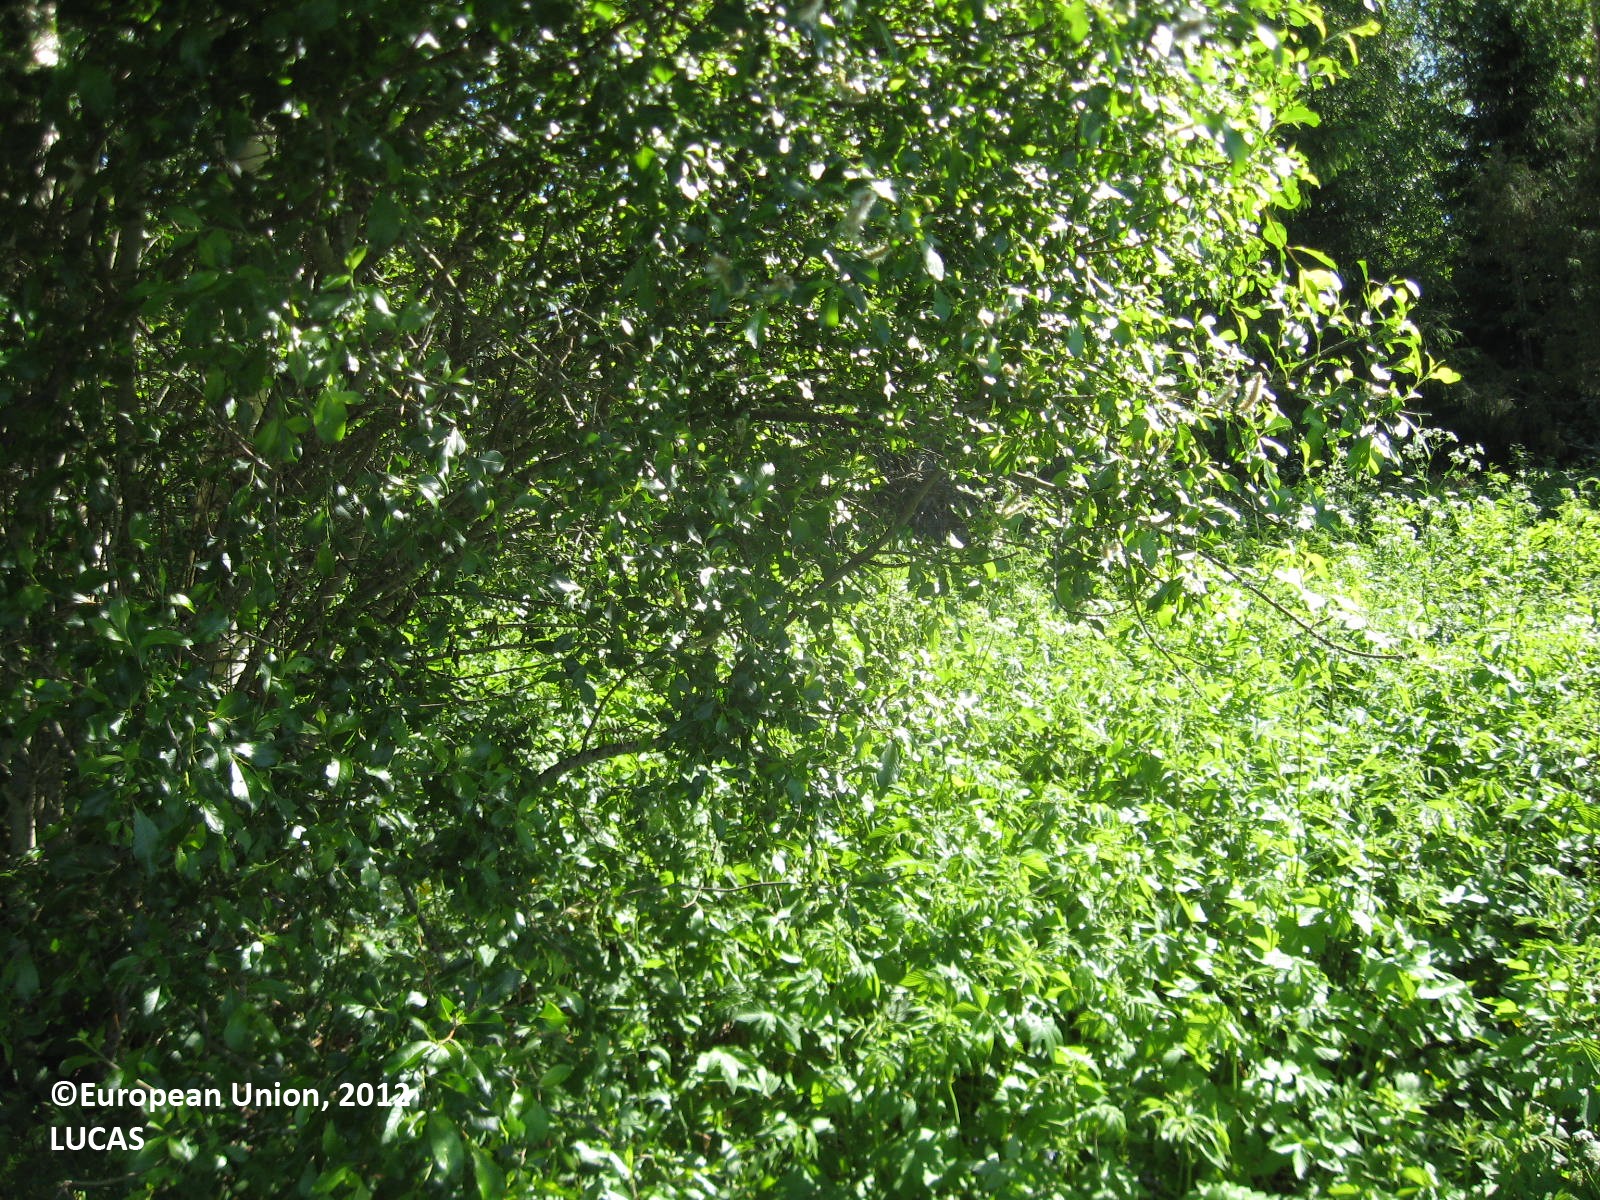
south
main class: Cropland
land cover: Common wheat
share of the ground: > 75 %
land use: Agriculture (excluding fallow land and kitchen gardens)
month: June
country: FI
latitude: 62.7933
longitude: 21.7085
